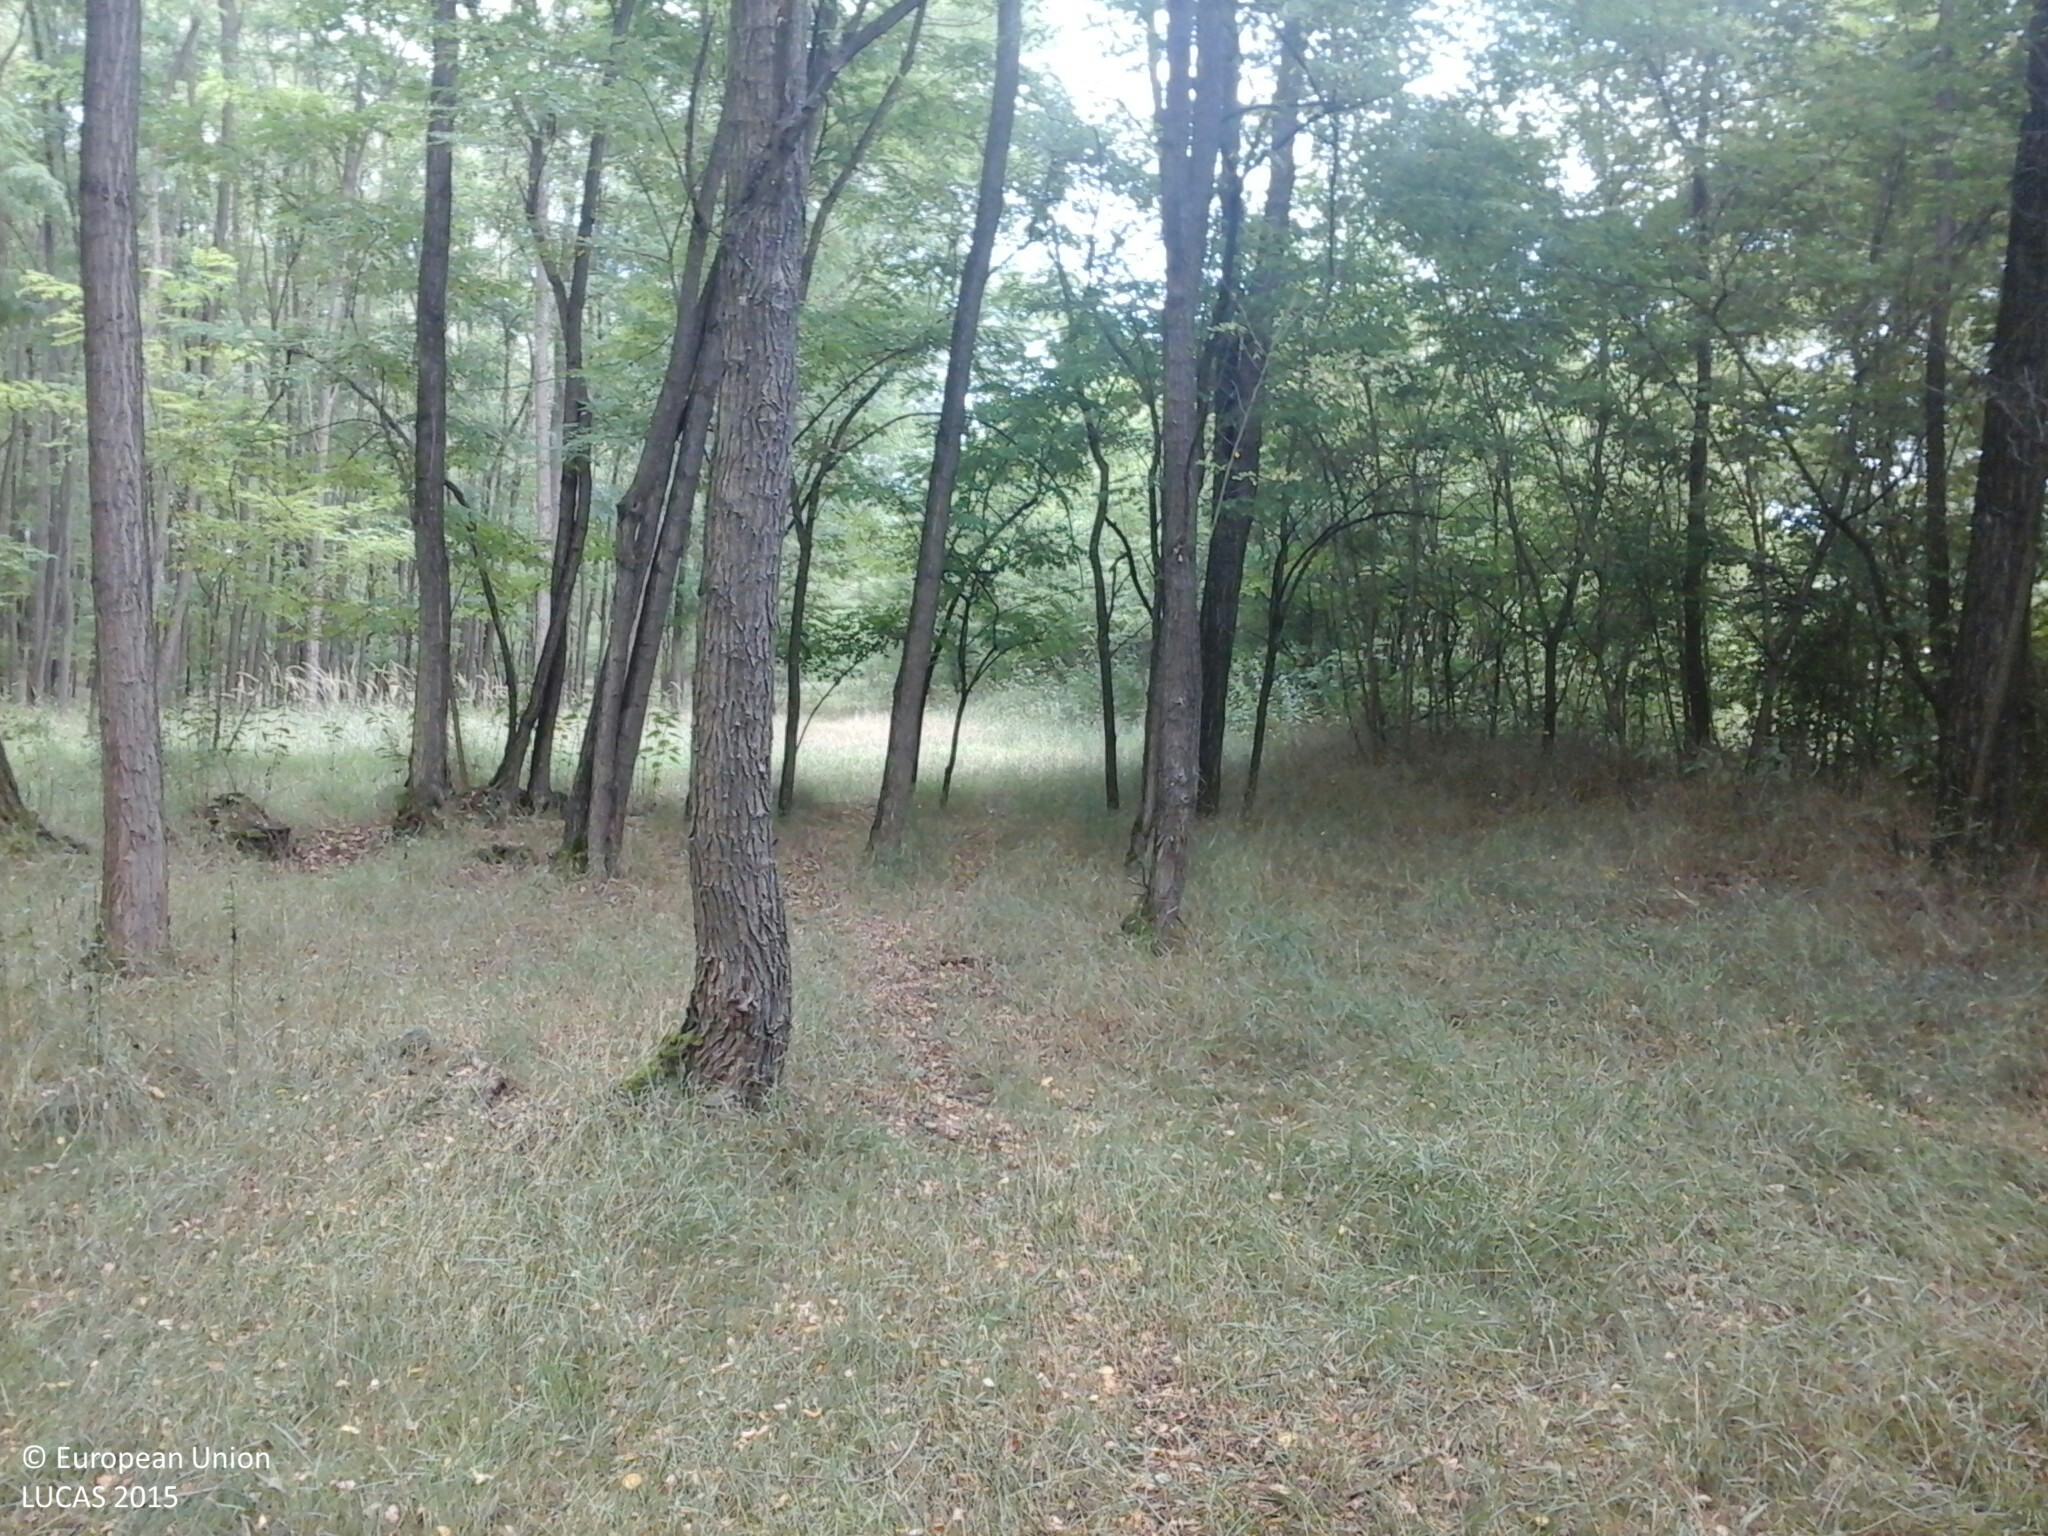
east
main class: Woodland
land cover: Broadleaved woodland
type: exotic forest
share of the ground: > 75 %
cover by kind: broadleaved forest trees 95 %, herbaceous plants 5 %
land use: Forestry
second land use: Agriculture (excluding fallow land and kitchen gardens)
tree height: > 5 m
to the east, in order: Broadleaved woodland; Tracks; Broadleaved woodland
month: July
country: HU
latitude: 48.1768
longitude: 22.2271
